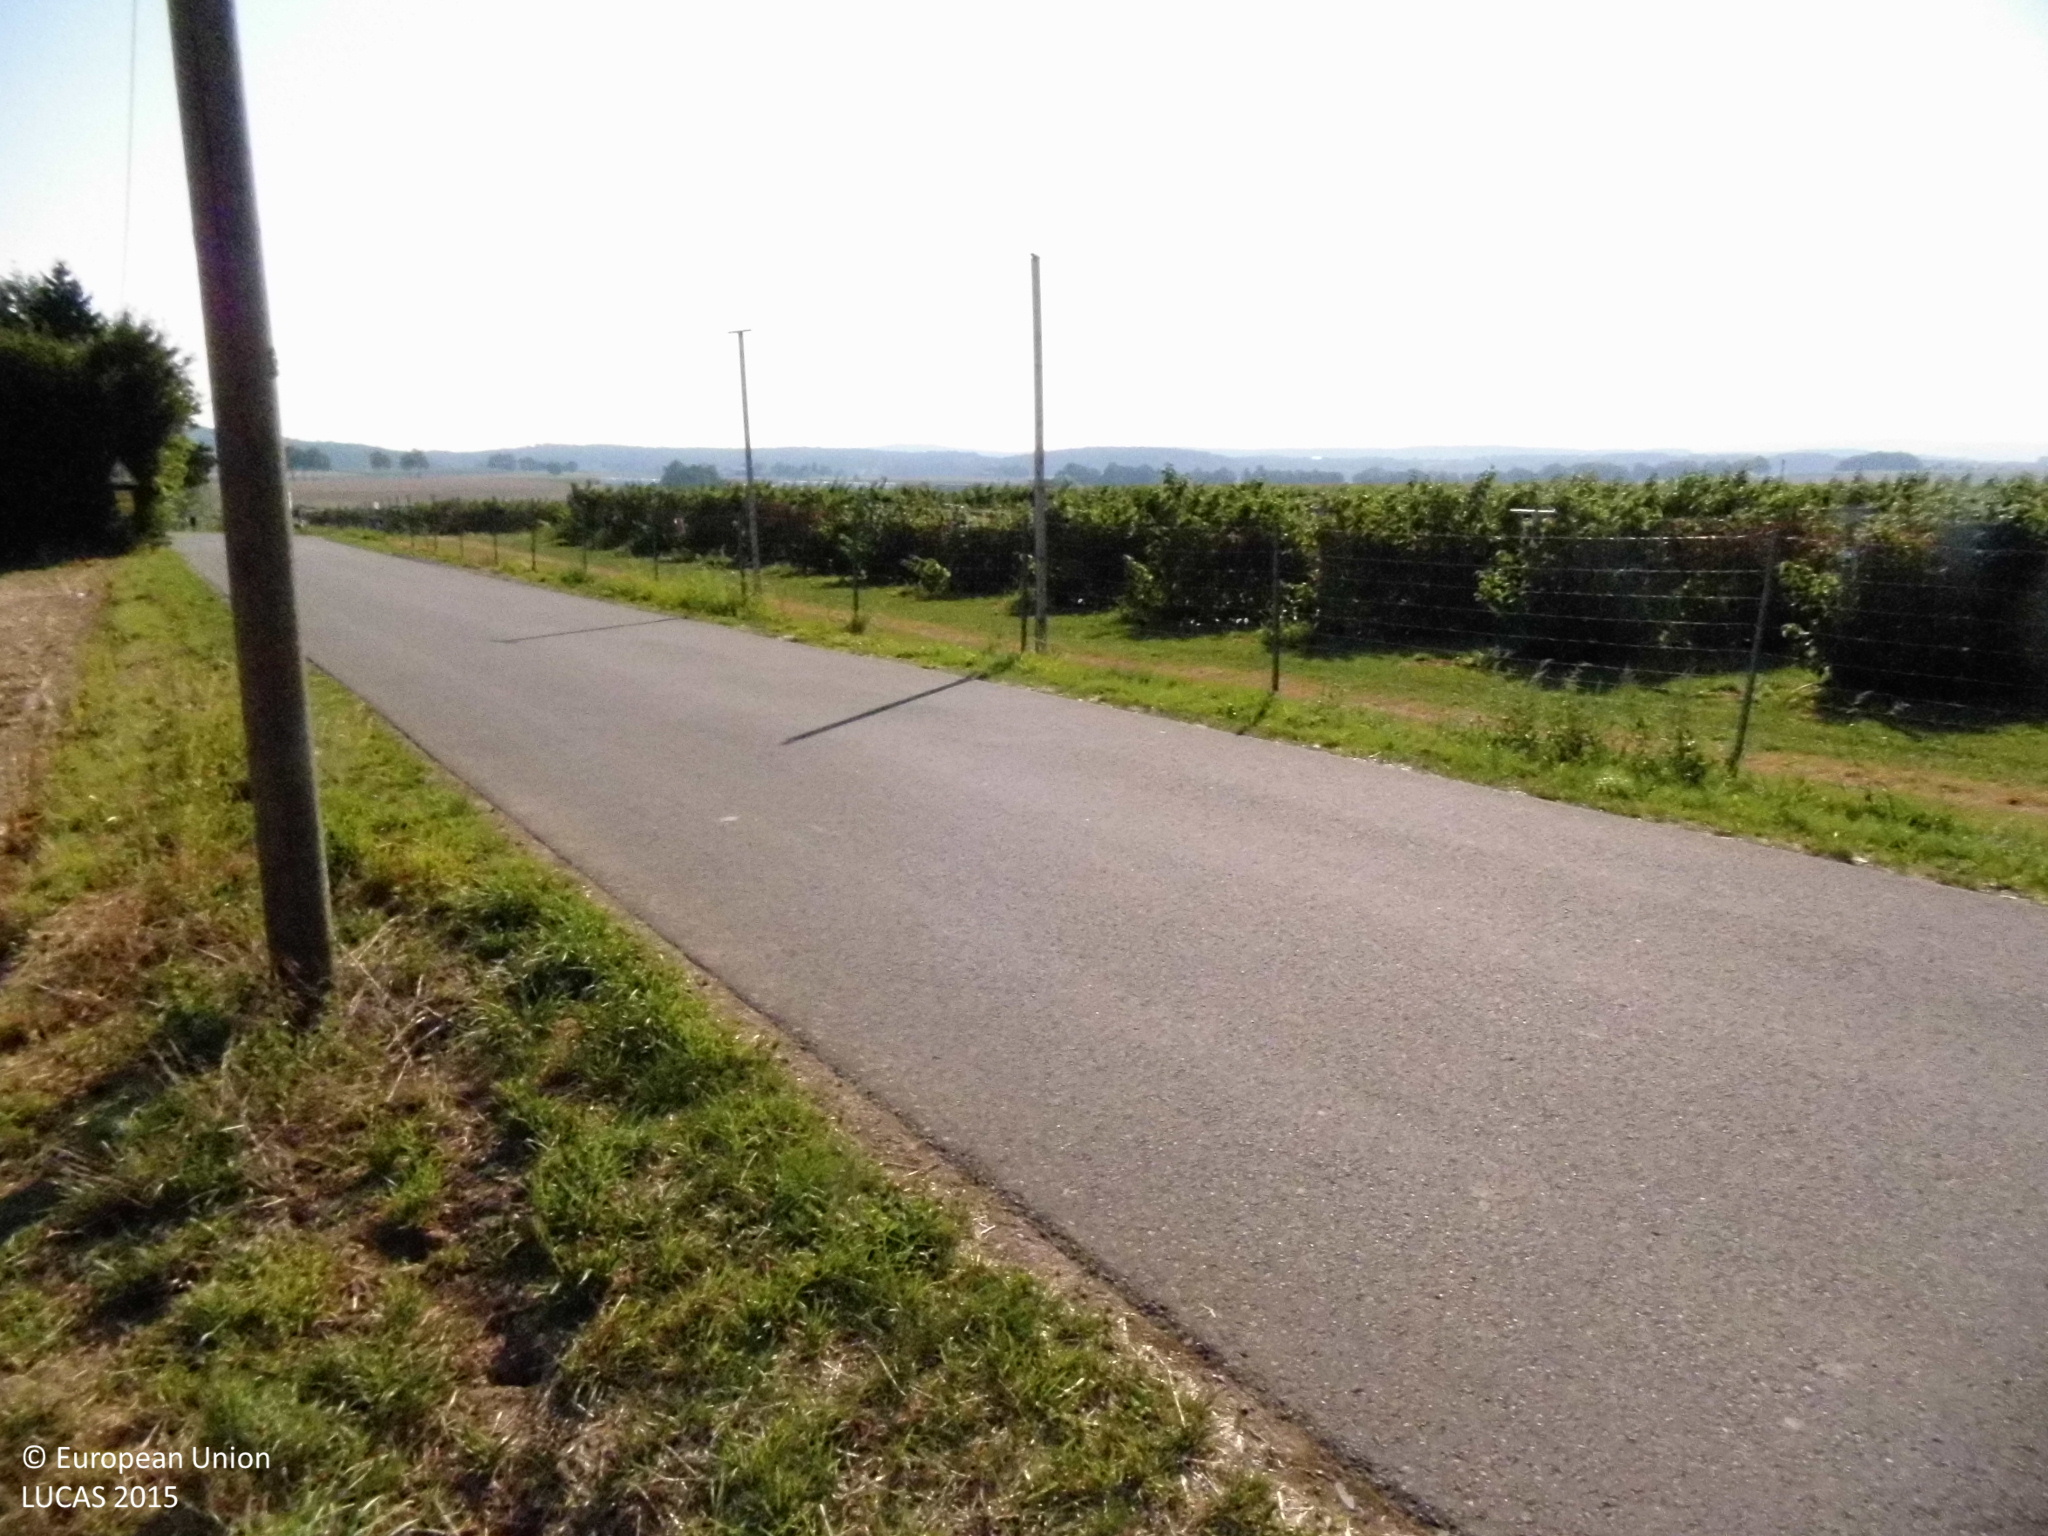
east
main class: Cropland
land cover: Common wheat
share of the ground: < 10 %
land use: Agriculture (excluding fallow land and kitchen gardens)
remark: Tilled/Sowed
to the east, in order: Common wheat; Broadleaved woodland; Artificial constructions in urban areas; Grassland without tree/shrub cover; Other fruit trees and berries; Grassland without tree/shrub cover; Fences; Grass margins; Paved roads, cycling and walking lanes; Shruby margins; Mixed cereals for fodder
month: August
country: DE
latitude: 50.4382
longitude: 8.0996
